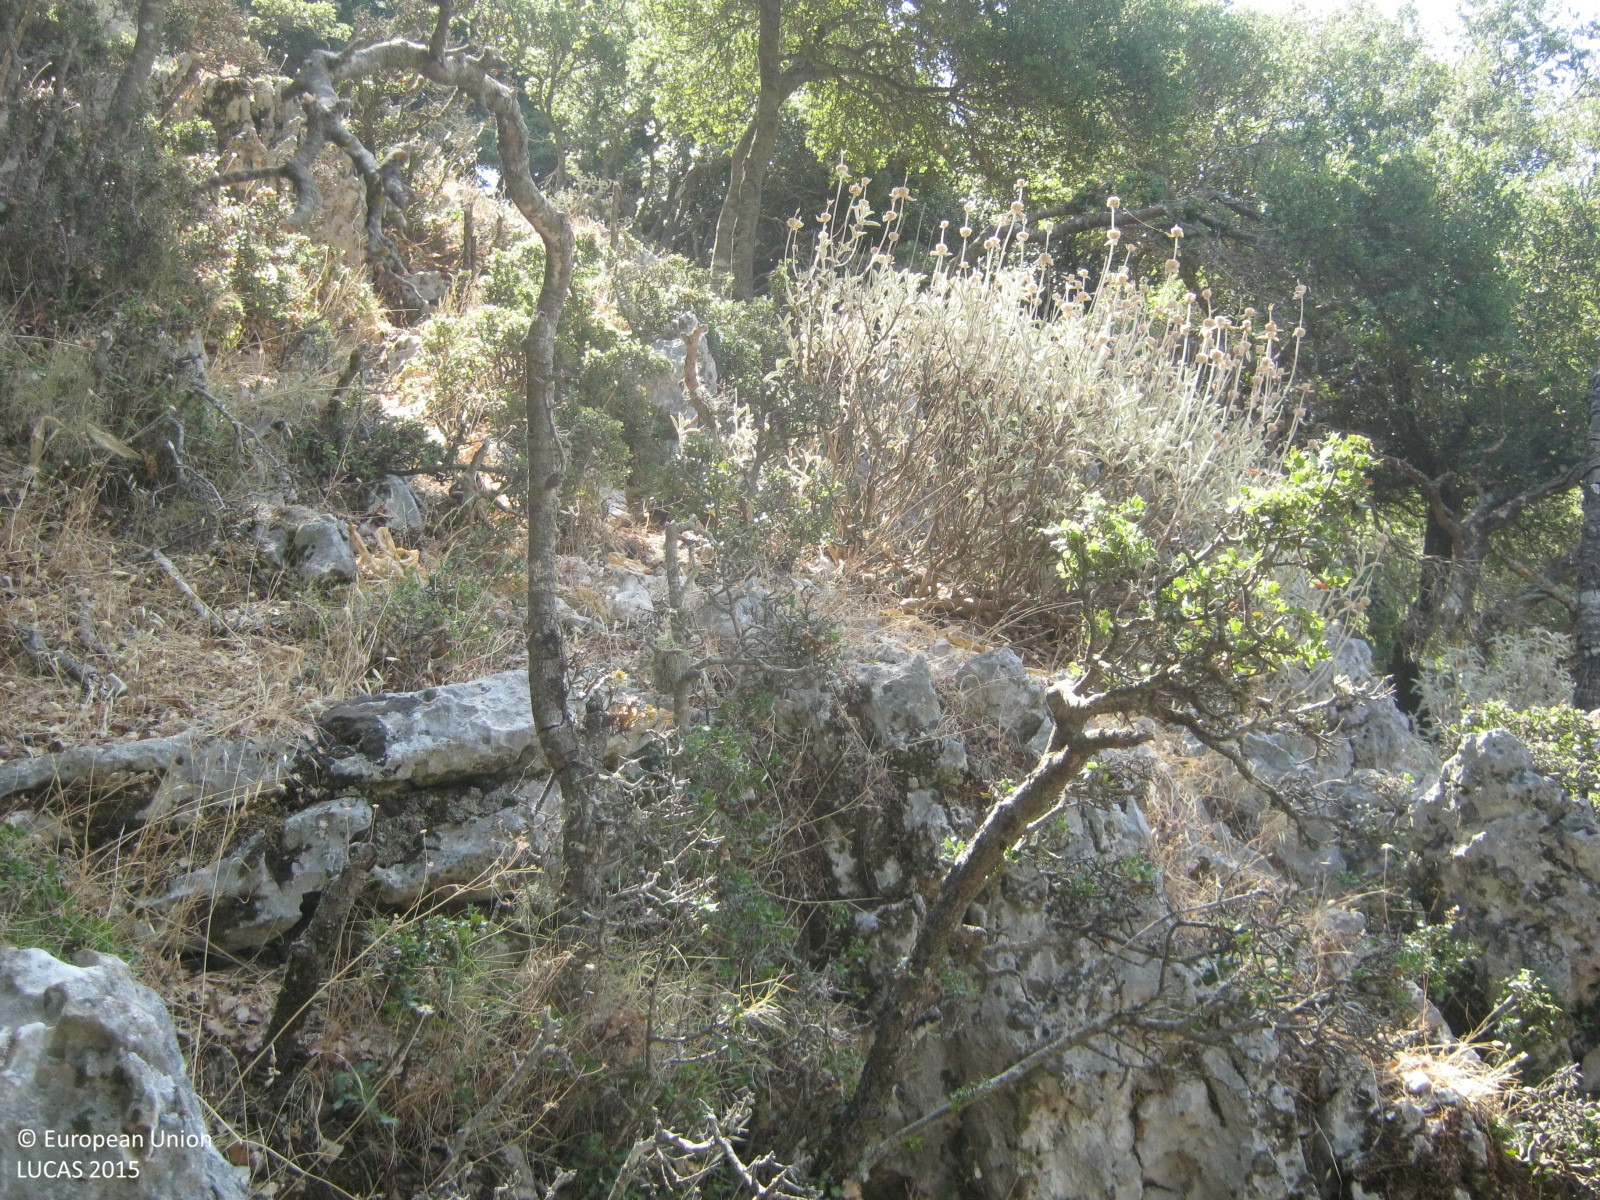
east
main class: Woodland
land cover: Broadleaved woodland
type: broadleaved evergreen forest
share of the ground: > 75 %
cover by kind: broadleaved forest trees 70 %, consolidated bare surface 20 %, shrubs 10 %
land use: Semi-natural and natural areas not in use
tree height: < 5 m
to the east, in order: Broadleaved woodland; Grassland with sparse tree/shrub cover; Rock outcrops; Grassland with sparse tree/shrub cover
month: August
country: GR
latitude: 38.3110
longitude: 20.5412
